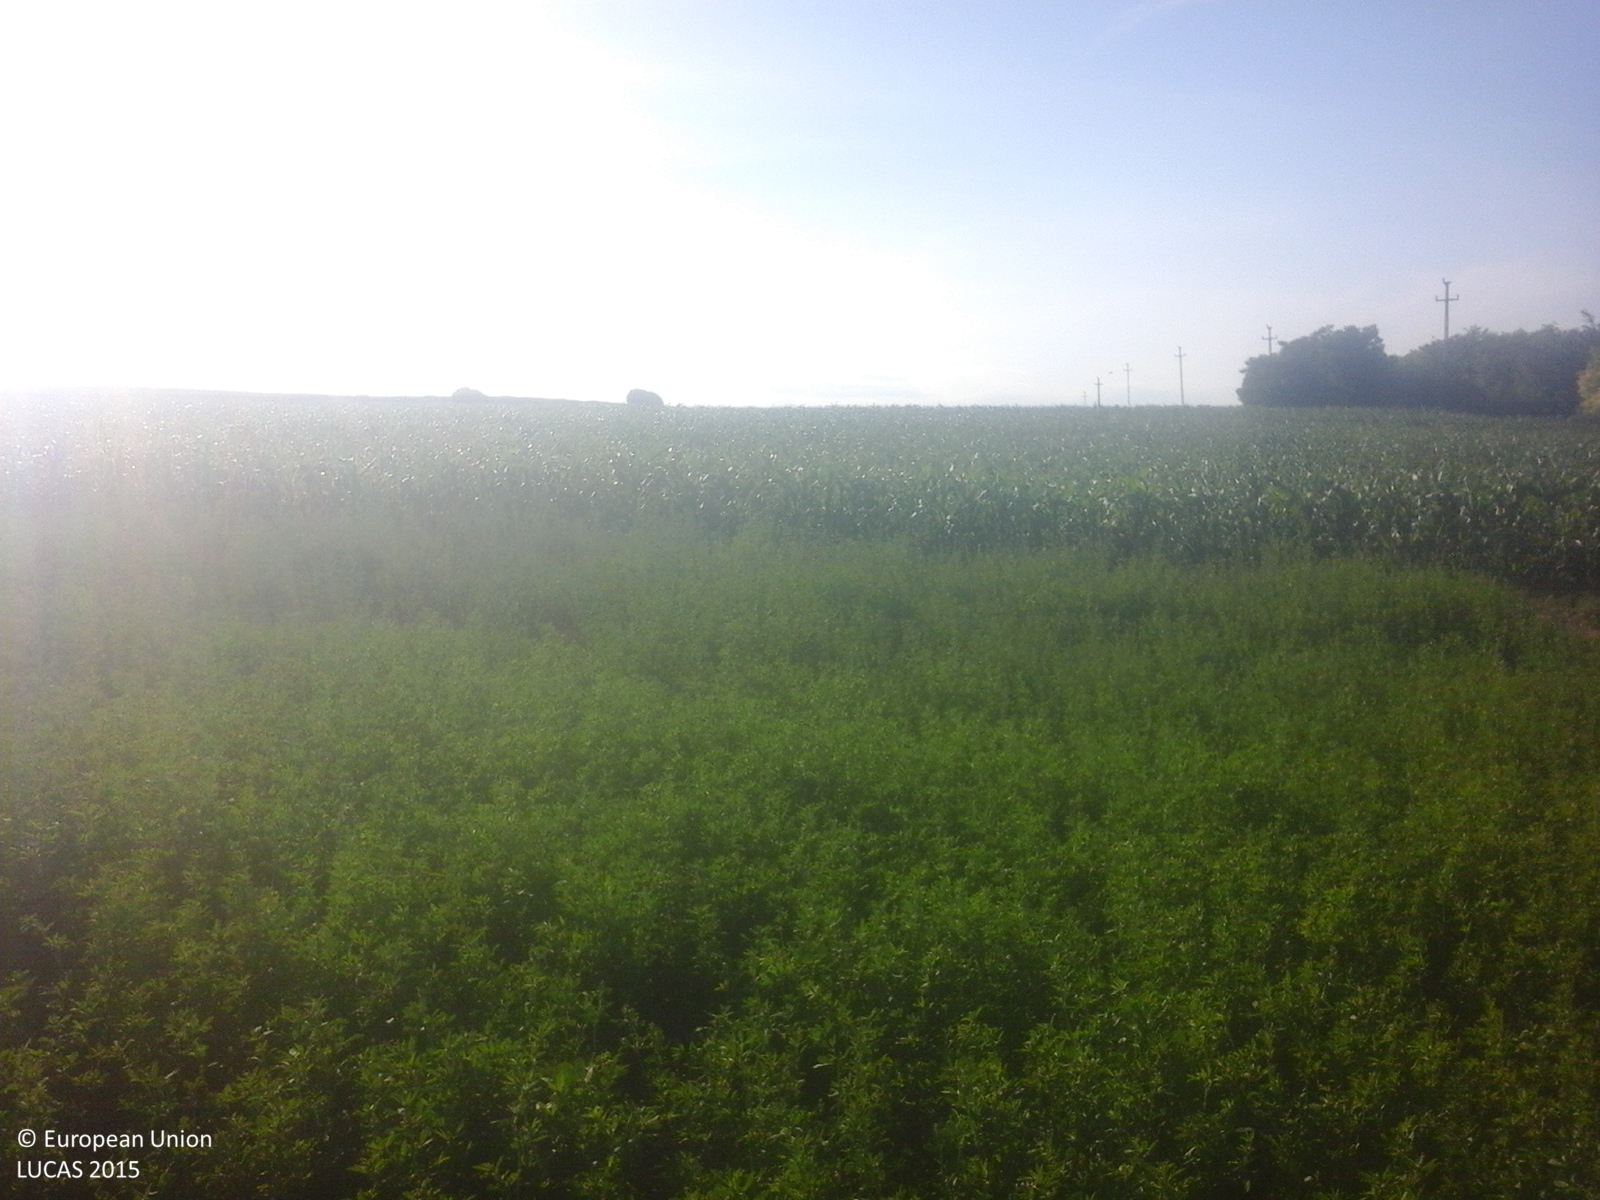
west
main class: Cropland
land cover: Lucerne
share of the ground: > 75 %
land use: Agriculture (excluding fallow land and kitchen gardens)
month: June
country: RO
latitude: 47.8796
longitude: 27.0214
